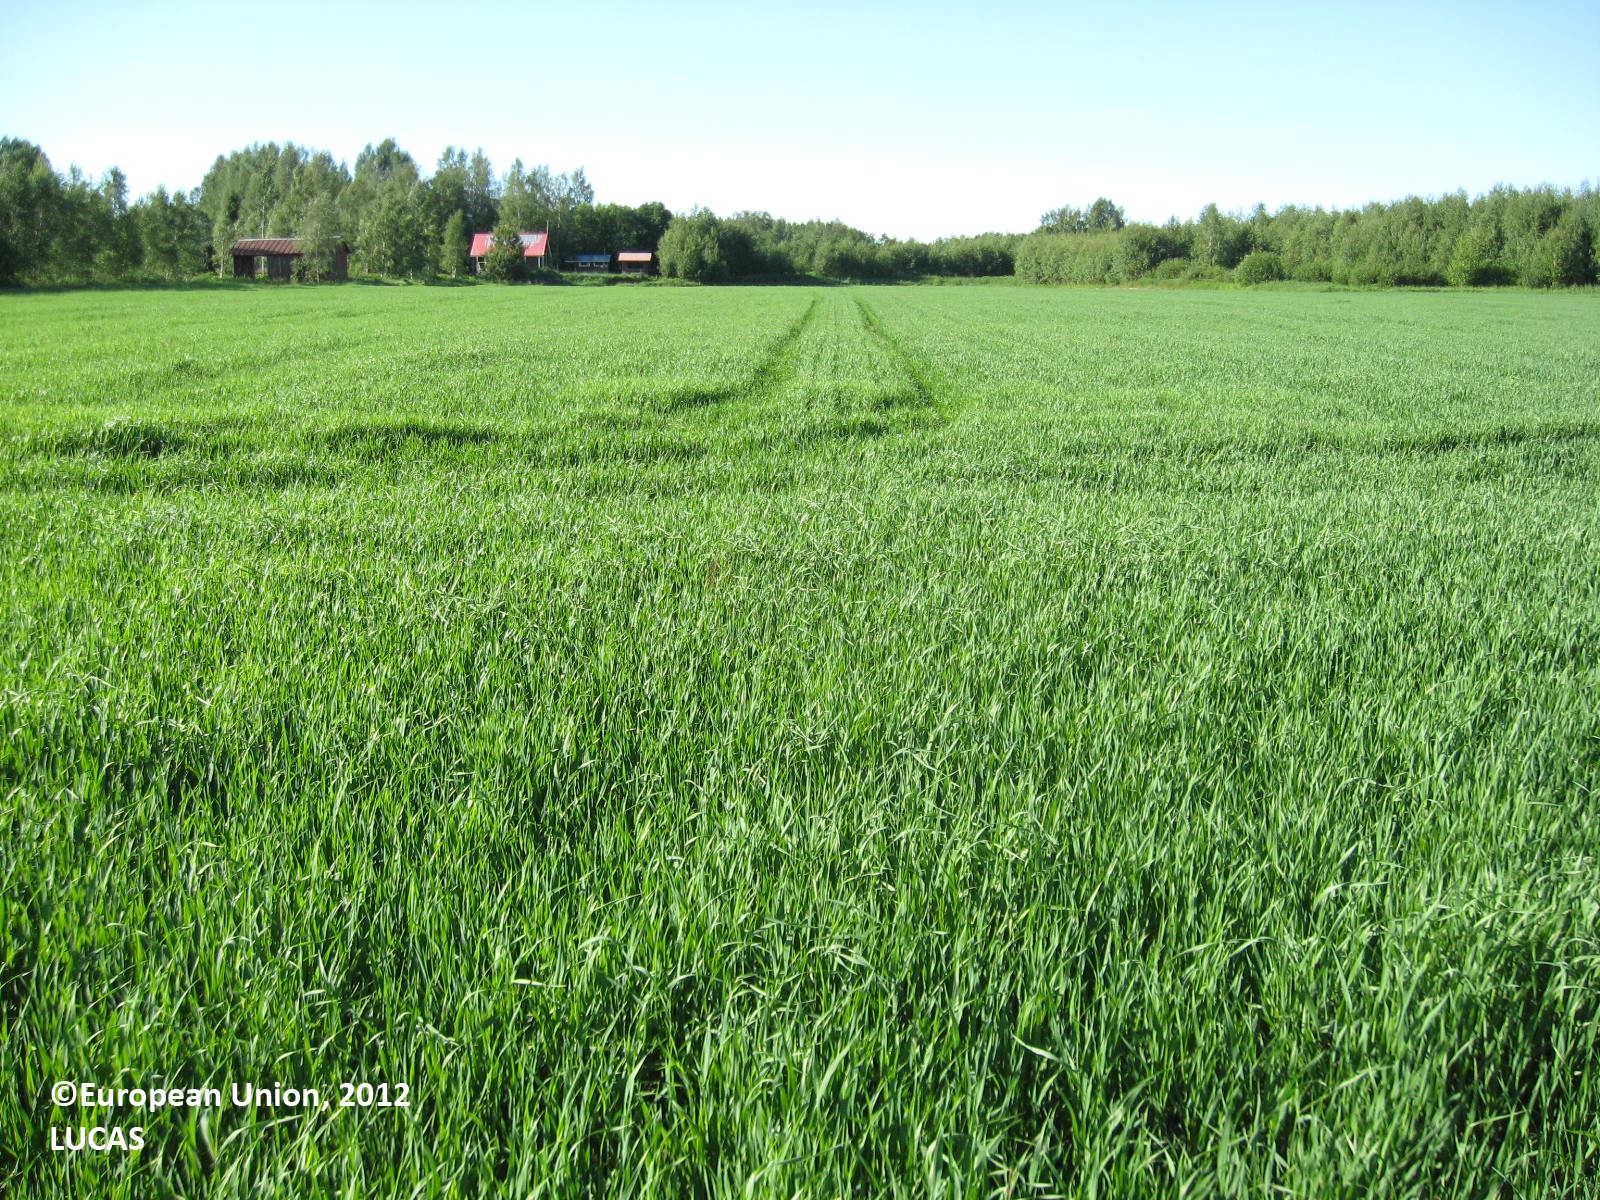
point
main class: Cropland
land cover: Oats
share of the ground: > 75 %
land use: Agriculture (excluding fallow land and kitchen gardens)
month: July
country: FI
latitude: 62.6606
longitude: 22.8829
